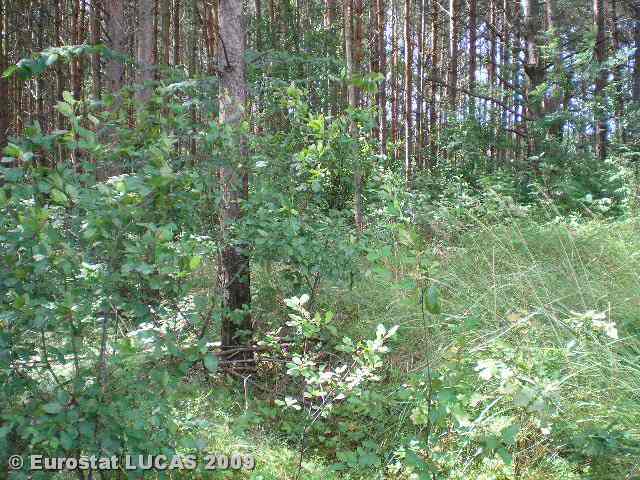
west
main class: Woodland
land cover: Mixed woodland
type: hemiboreal forest and nemoral coniferous forest and mixed broadleaved-coniferous forest
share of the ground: > 75 %
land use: Forestry
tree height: > 5 m
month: July
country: LT
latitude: 54.8674
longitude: 25.3777
